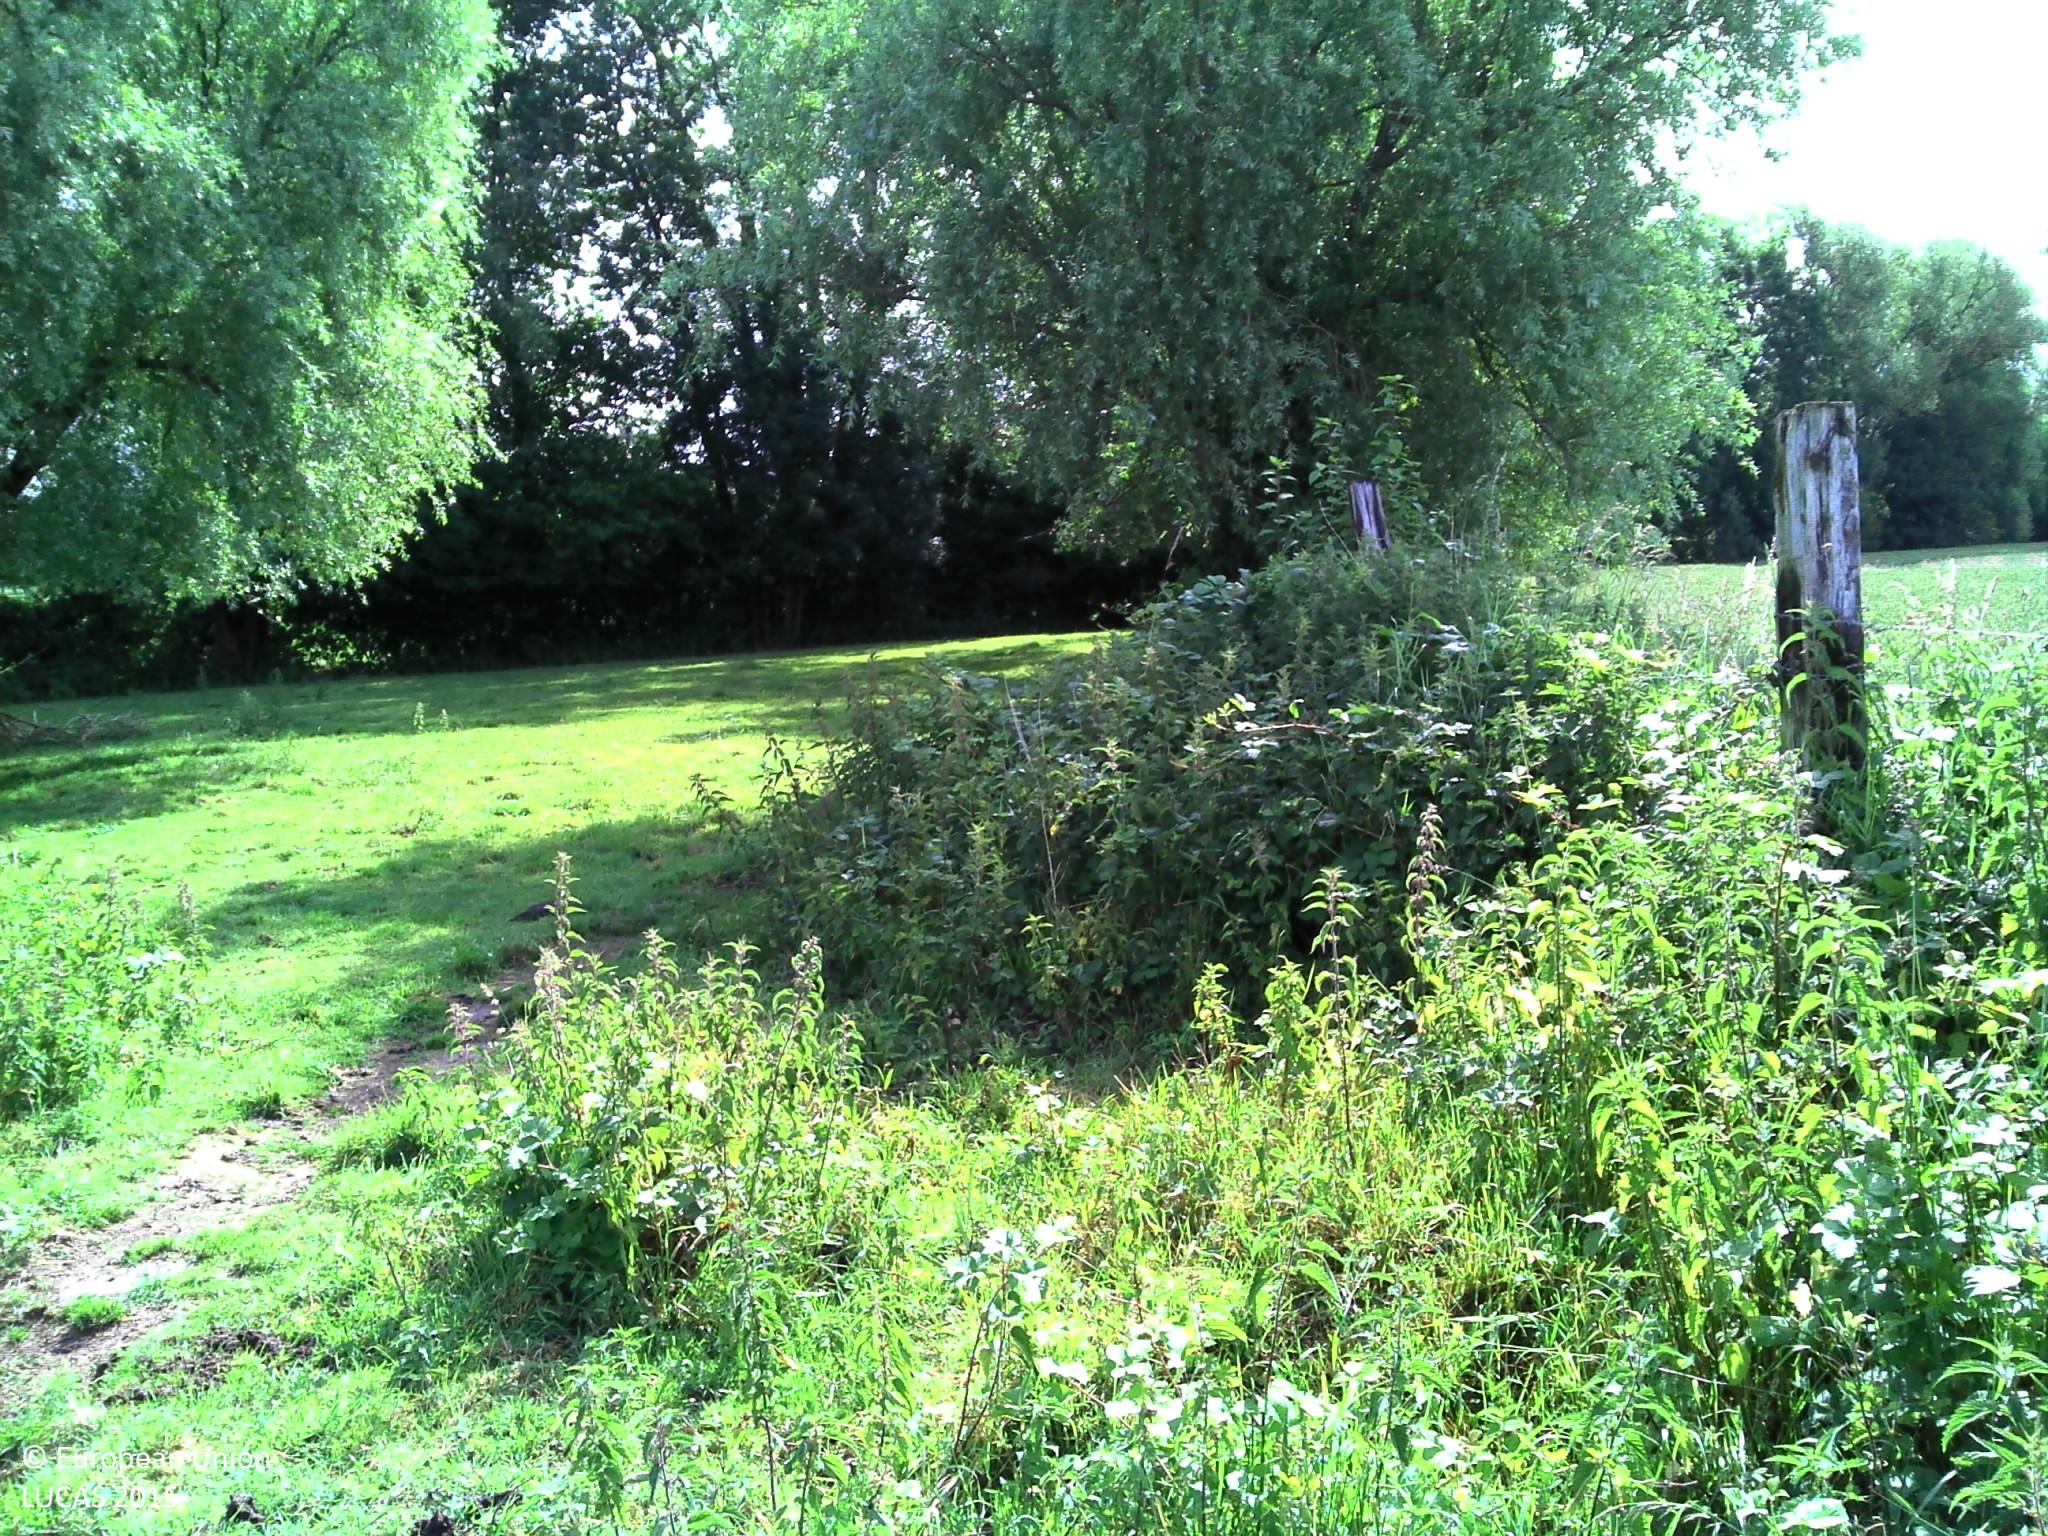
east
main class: Grassland
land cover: Grassland with sparse tree/shrub cover
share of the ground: 50 - 75 %
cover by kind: herbaceous plants 85 %, shrubs 10 %, broadleaved forest trees 5 %
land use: Agriculture (excluding fallow land and kitchen gardens)
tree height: > 5 m
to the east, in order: Grassland with sparse tree/shrub cover; Fences; Ditches and canals; Abandoned hedges; Grassland without tree/shrub cover; Fences; Grassland without tree/shrub cover; Lines of trees; Grassland without tree/shrub cover; Abandoned hedges; Artificial constructions in urban areas
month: June
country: BE
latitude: 50.5281
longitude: 3.9422
